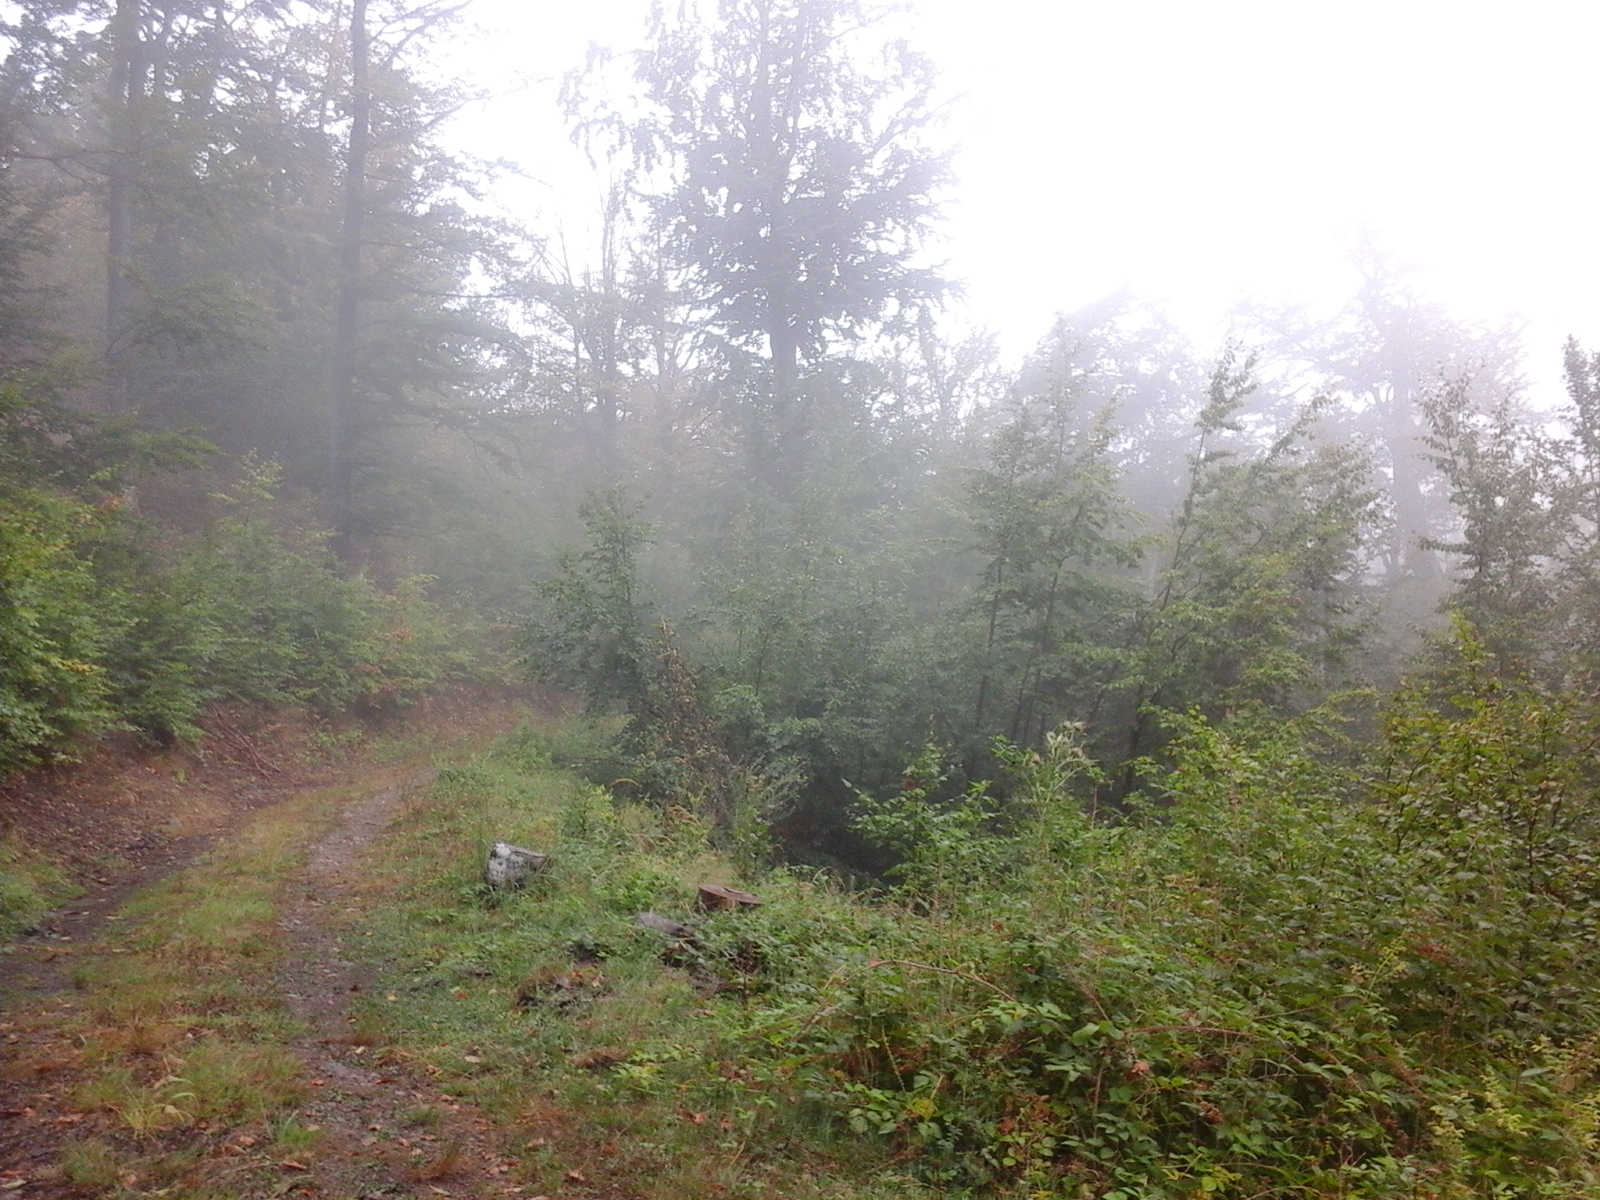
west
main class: Woodland
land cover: Broadleaved woodland
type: beech forest
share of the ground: > 75 %
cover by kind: broadleaved forest trees 100 %
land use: Forestry
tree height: > 5 m
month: August
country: RO
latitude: 45.0404
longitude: 22.7276
